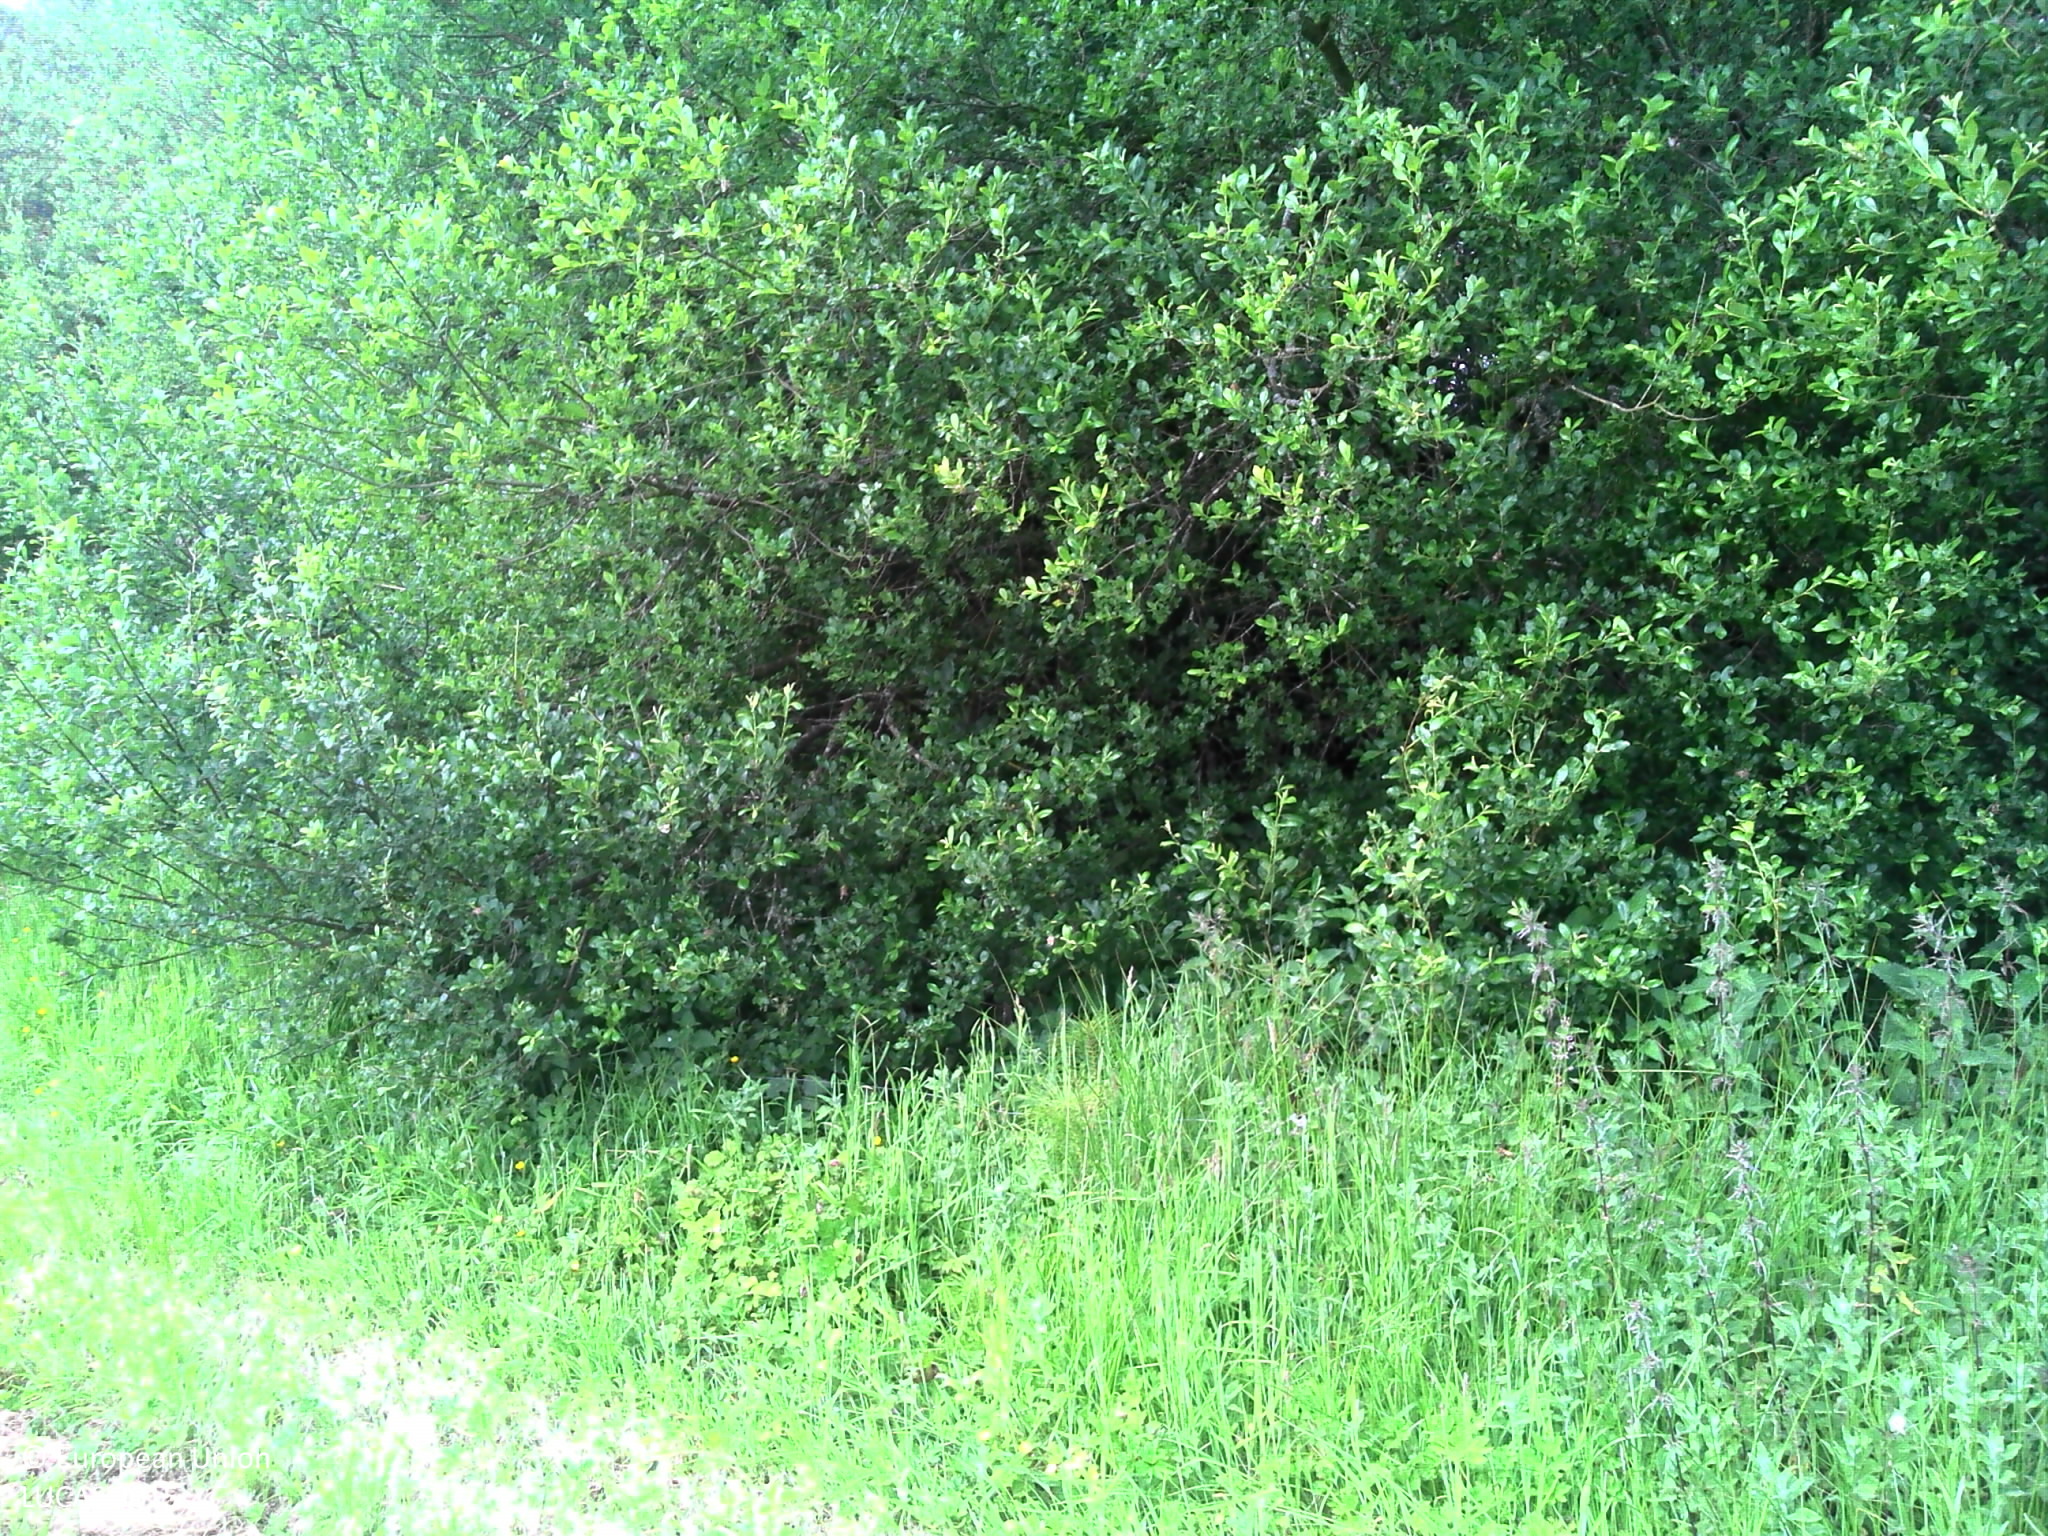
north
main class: Grassland
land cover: Grassland without tree/shrub cover
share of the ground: > 75 %
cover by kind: herbaceous plants 100 %
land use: Agriculture (excluding fallow land and kitchen gardens)
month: June
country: FR
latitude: 49.5001
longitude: -1.4122
